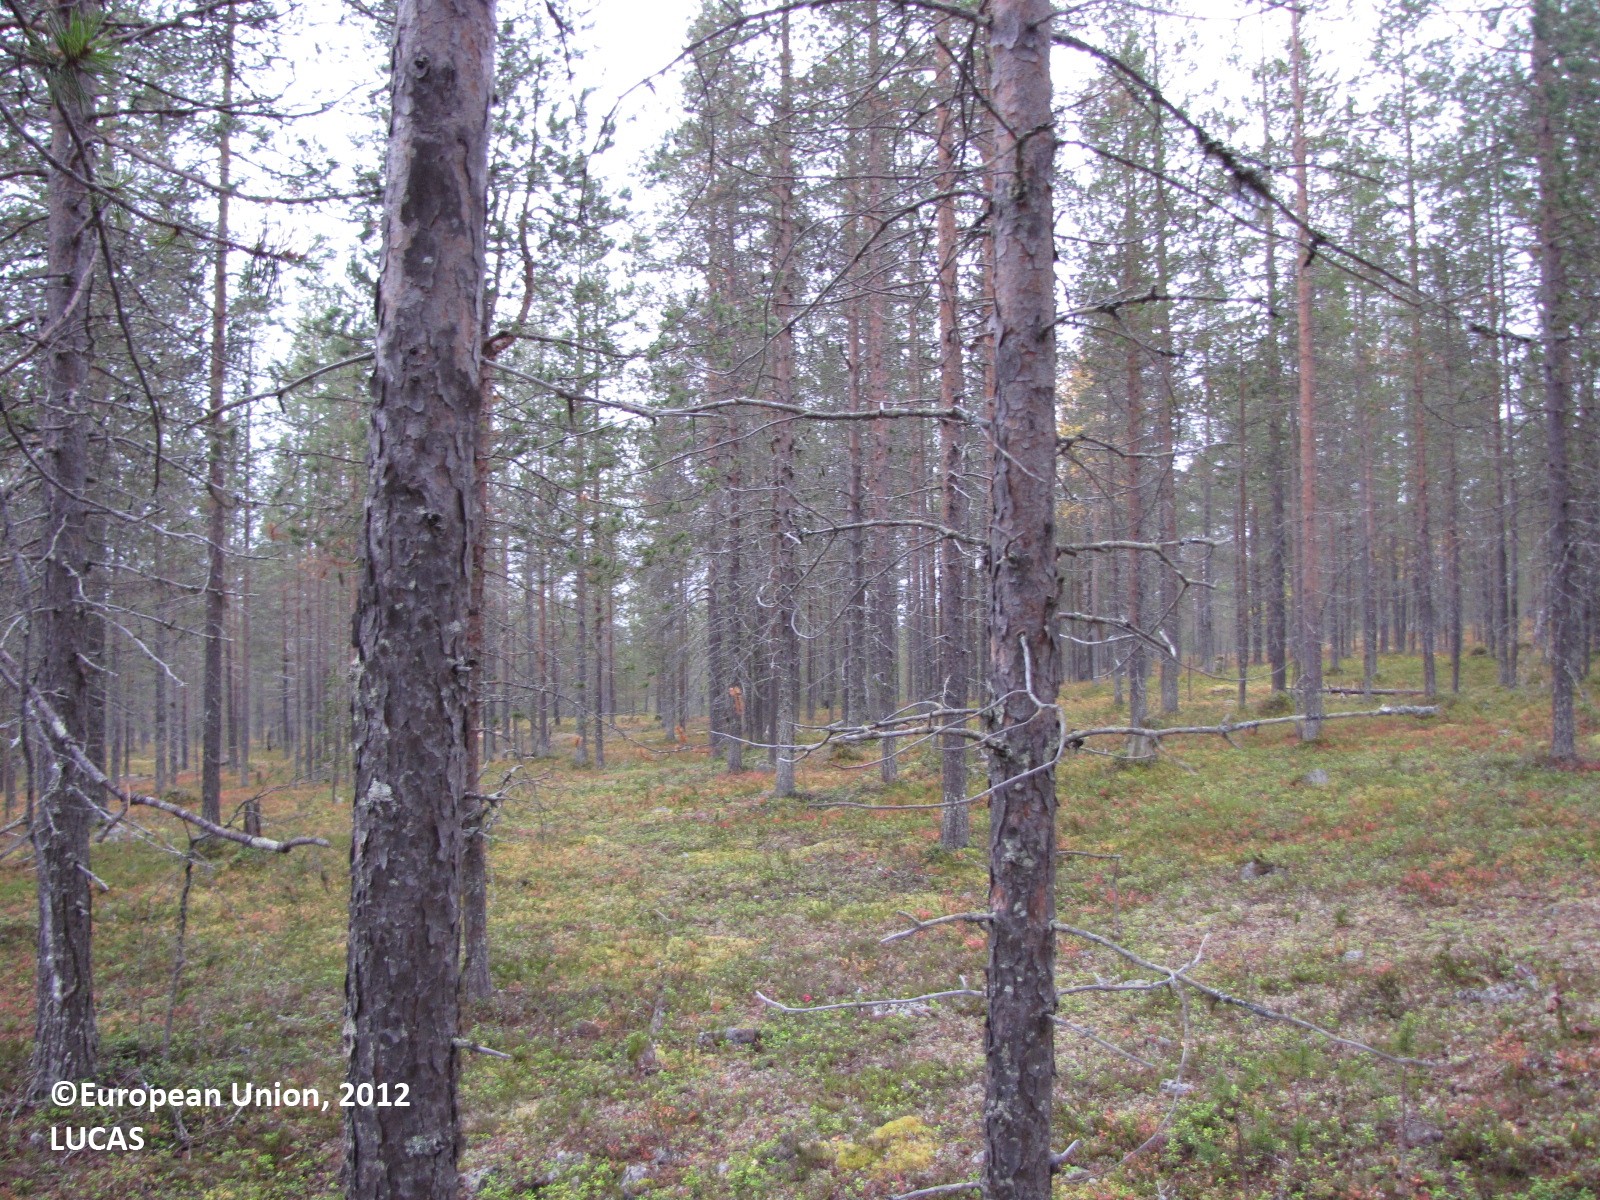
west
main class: Woodland
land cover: Pine dominated coniferous woodland
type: boreal forest
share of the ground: 25 - 50 %
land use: Forestry
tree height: > 5 m
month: September
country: FI
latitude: 67.5868
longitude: 24.0534
